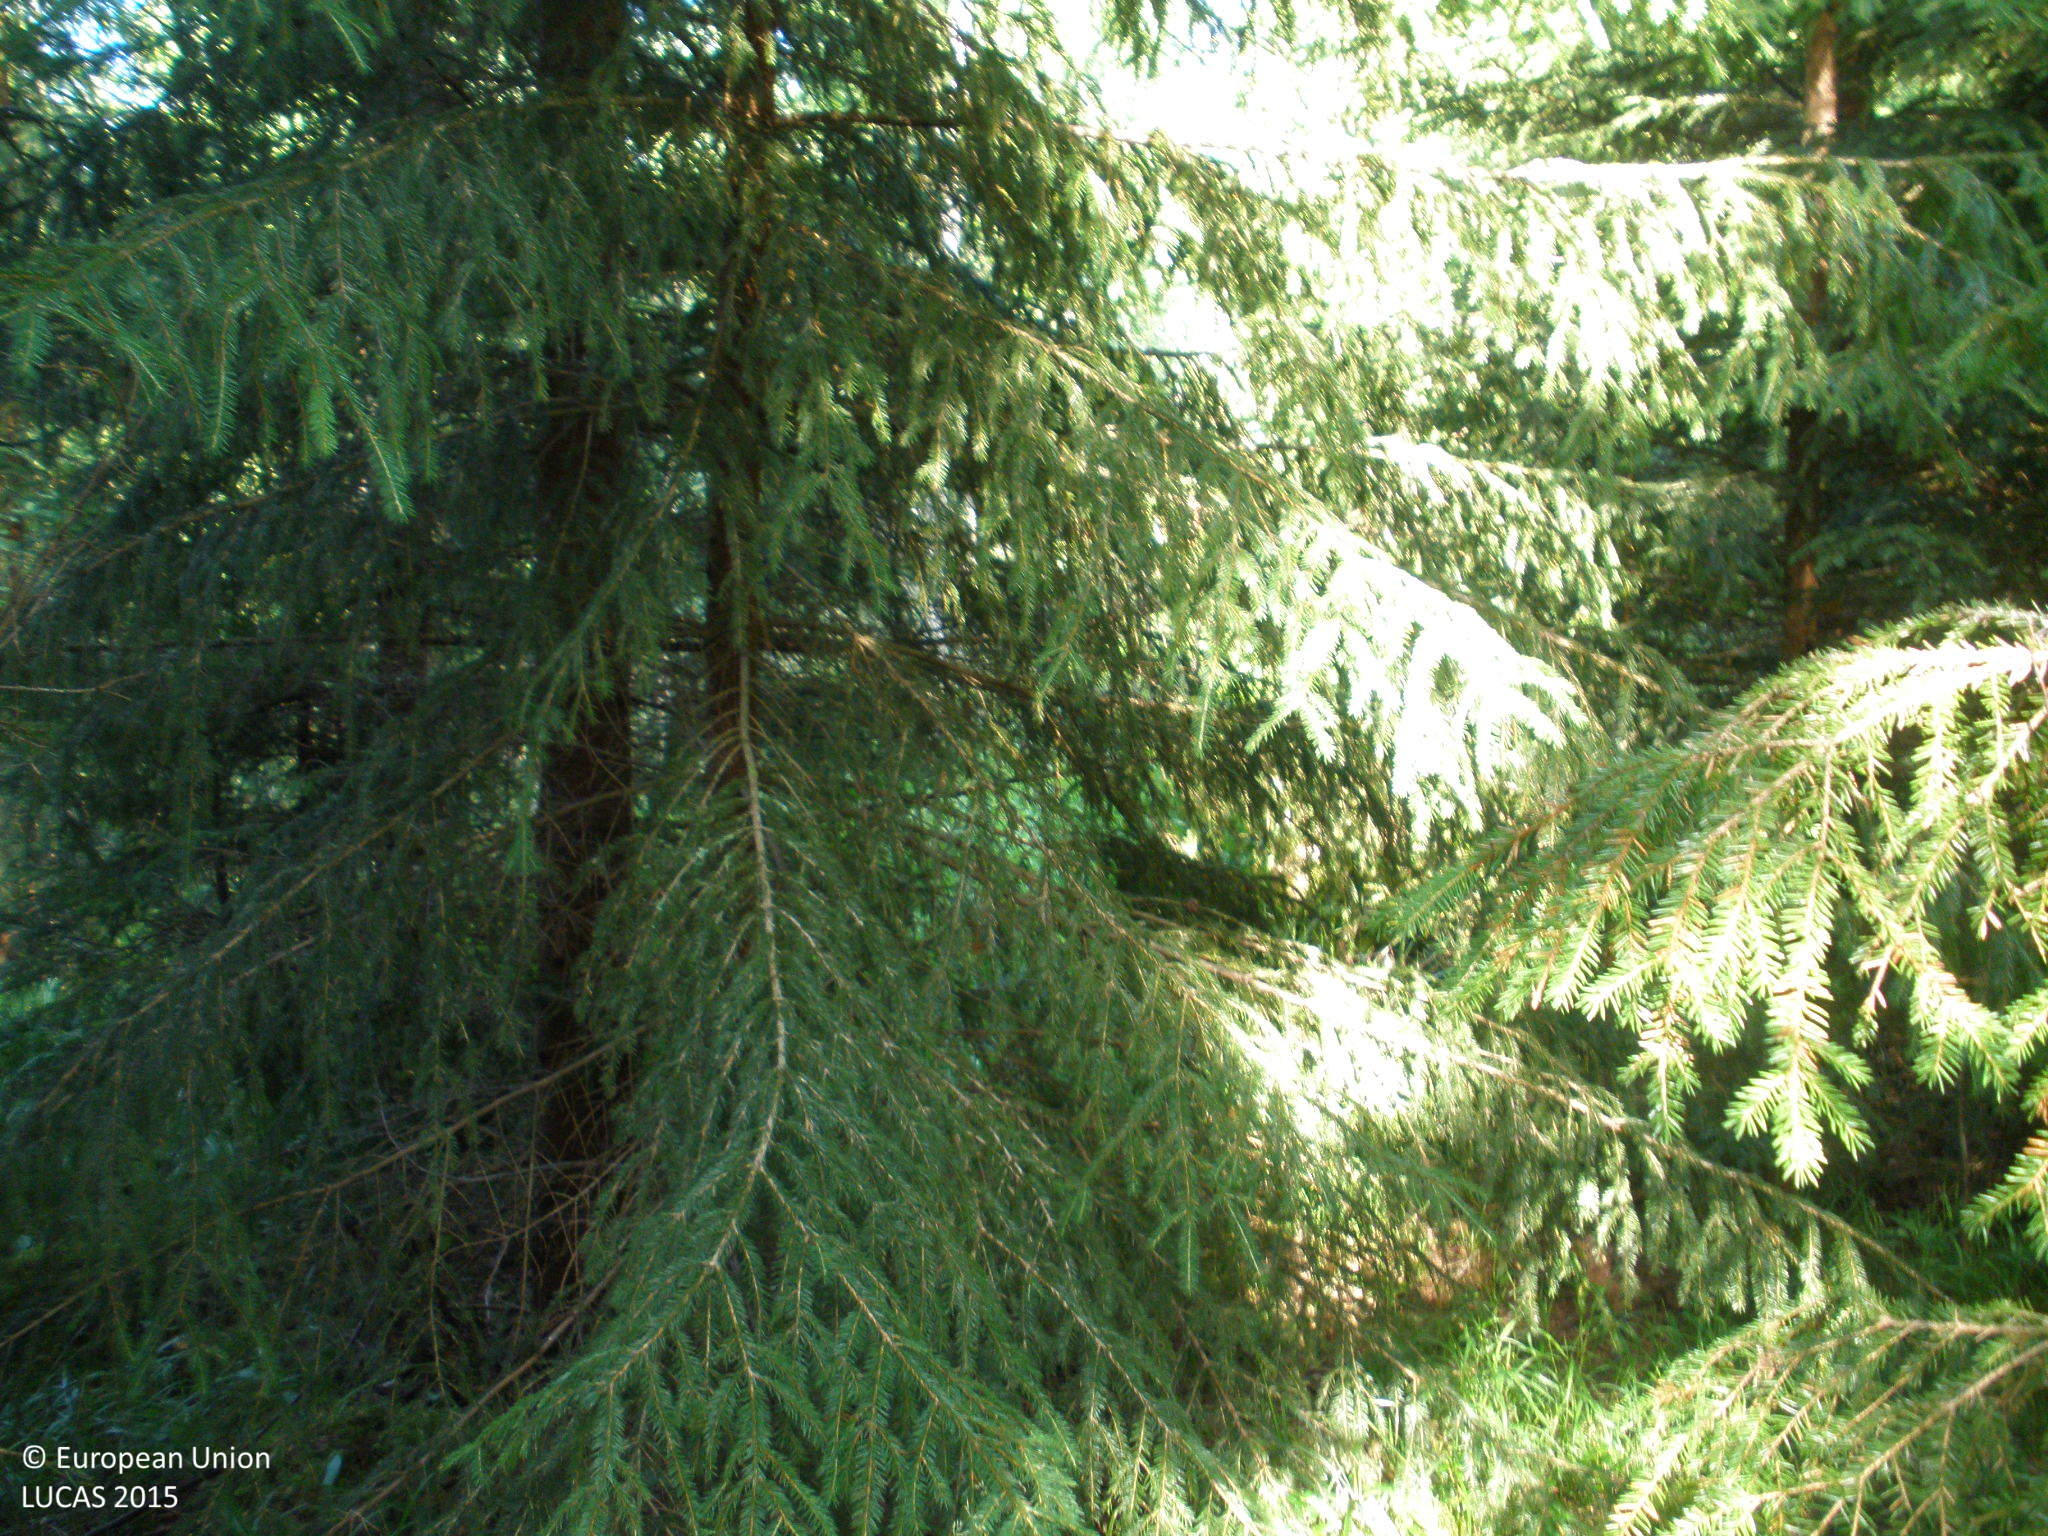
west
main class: Woodland
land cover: Spruce dominated mixed woodland
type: boreal forest
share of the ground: > 75 %
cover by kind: coniferous forest trees 65 %, broadleaved forest trees 25 %, herbaceous plants 10 %
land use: Forestry
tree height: > 5 m
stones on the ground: 10 - 25 %
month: July
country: FI
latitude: 61.1769
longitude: 24.9682
